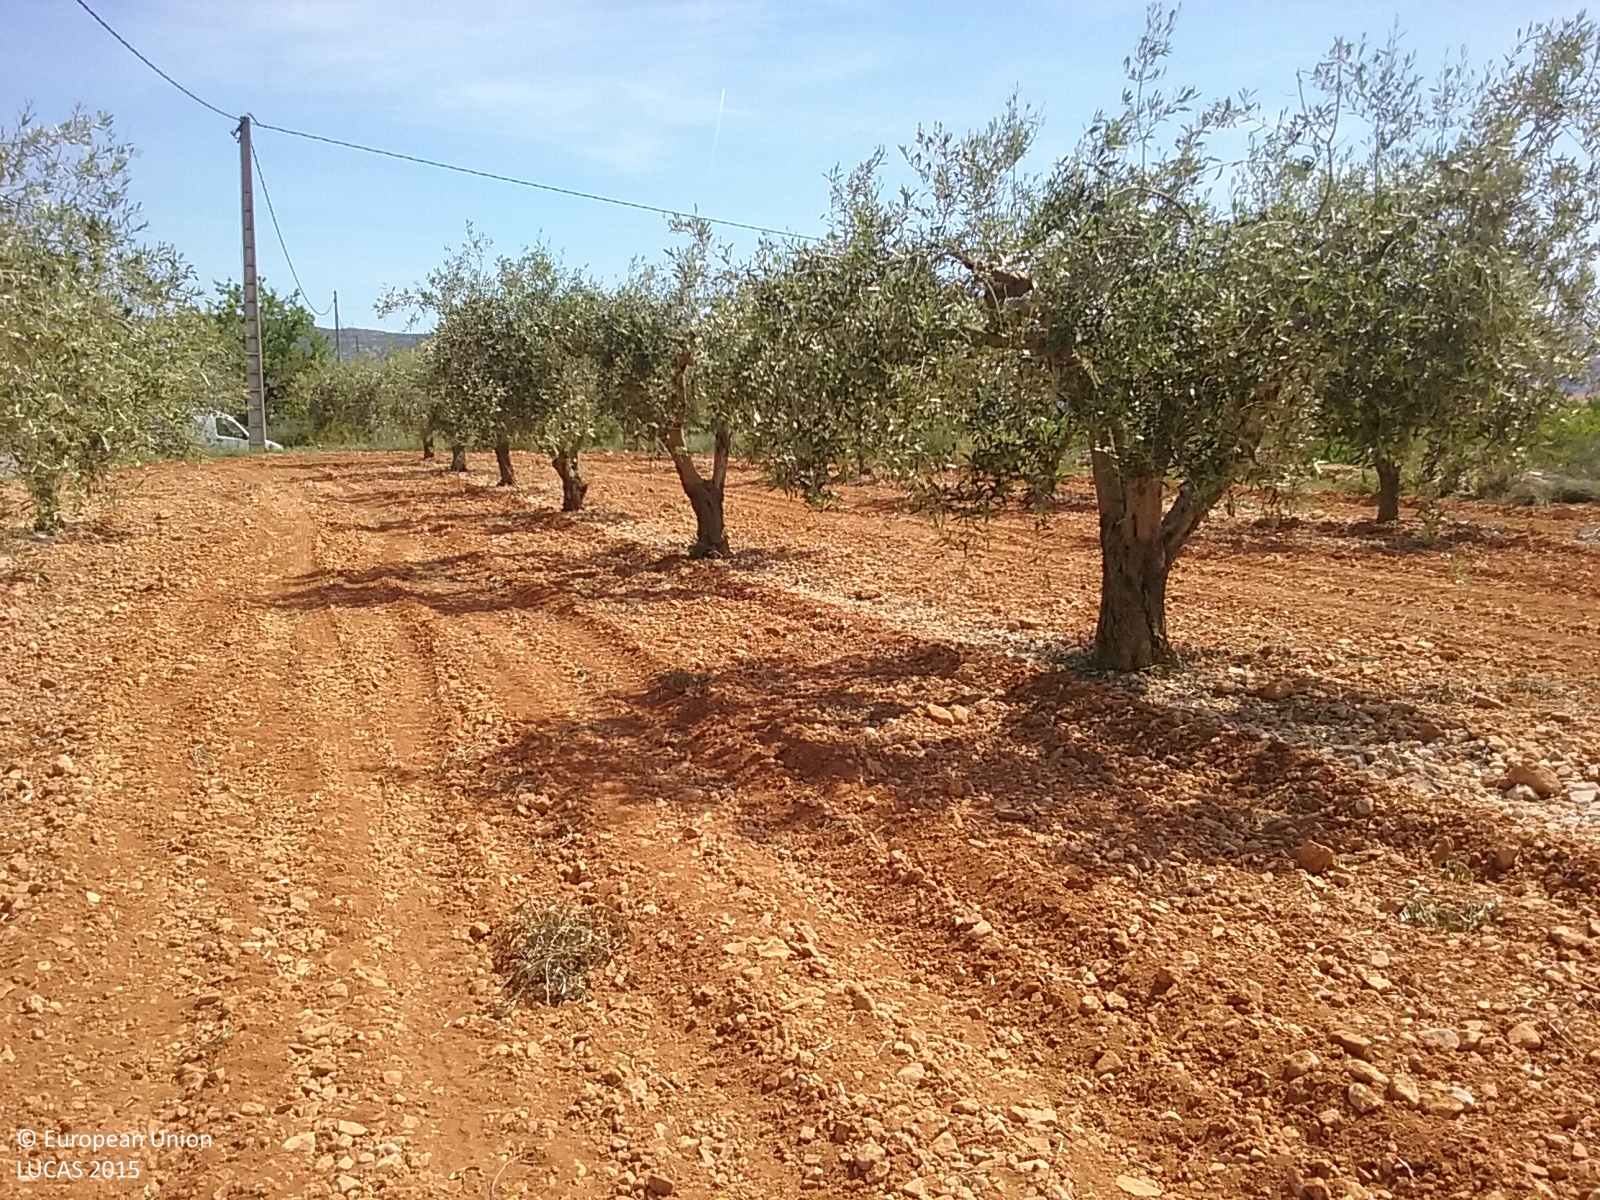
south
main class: Cropland
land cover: Olive groves
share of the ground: 25 - 50 %
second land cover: Other bare soil
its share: > 75 %
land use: Agriculture (excluding fallow land and kitchen gardens)
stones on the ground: 25 - 50 %
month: May
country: ES
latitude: 40.1746
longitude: 0.0039
